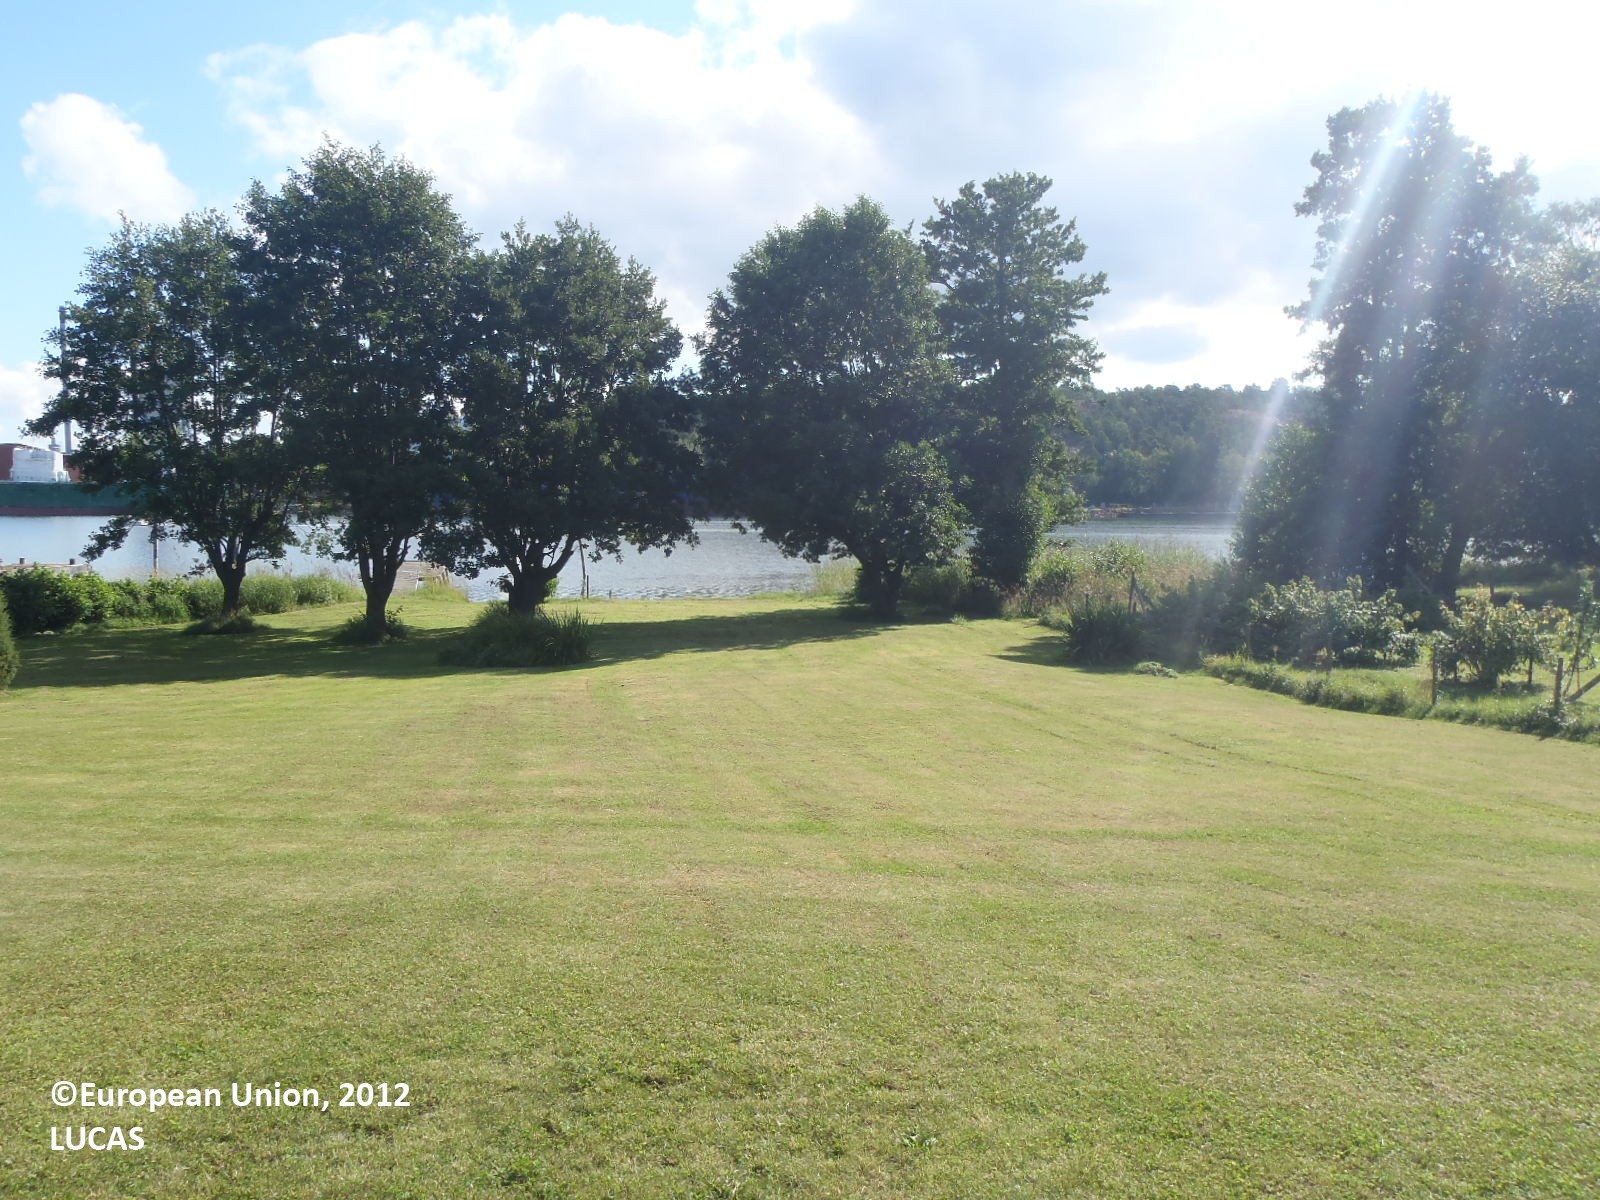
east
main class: Grassland
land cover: Grassland without tree/shrub cover
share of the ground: > 75 %
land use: Residential
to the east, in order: Grassland without tree/shrub cover; Lines of trees; Grassland without tree/shrub cover
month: August
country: FI
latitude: 60.1030
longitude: 19.9170
